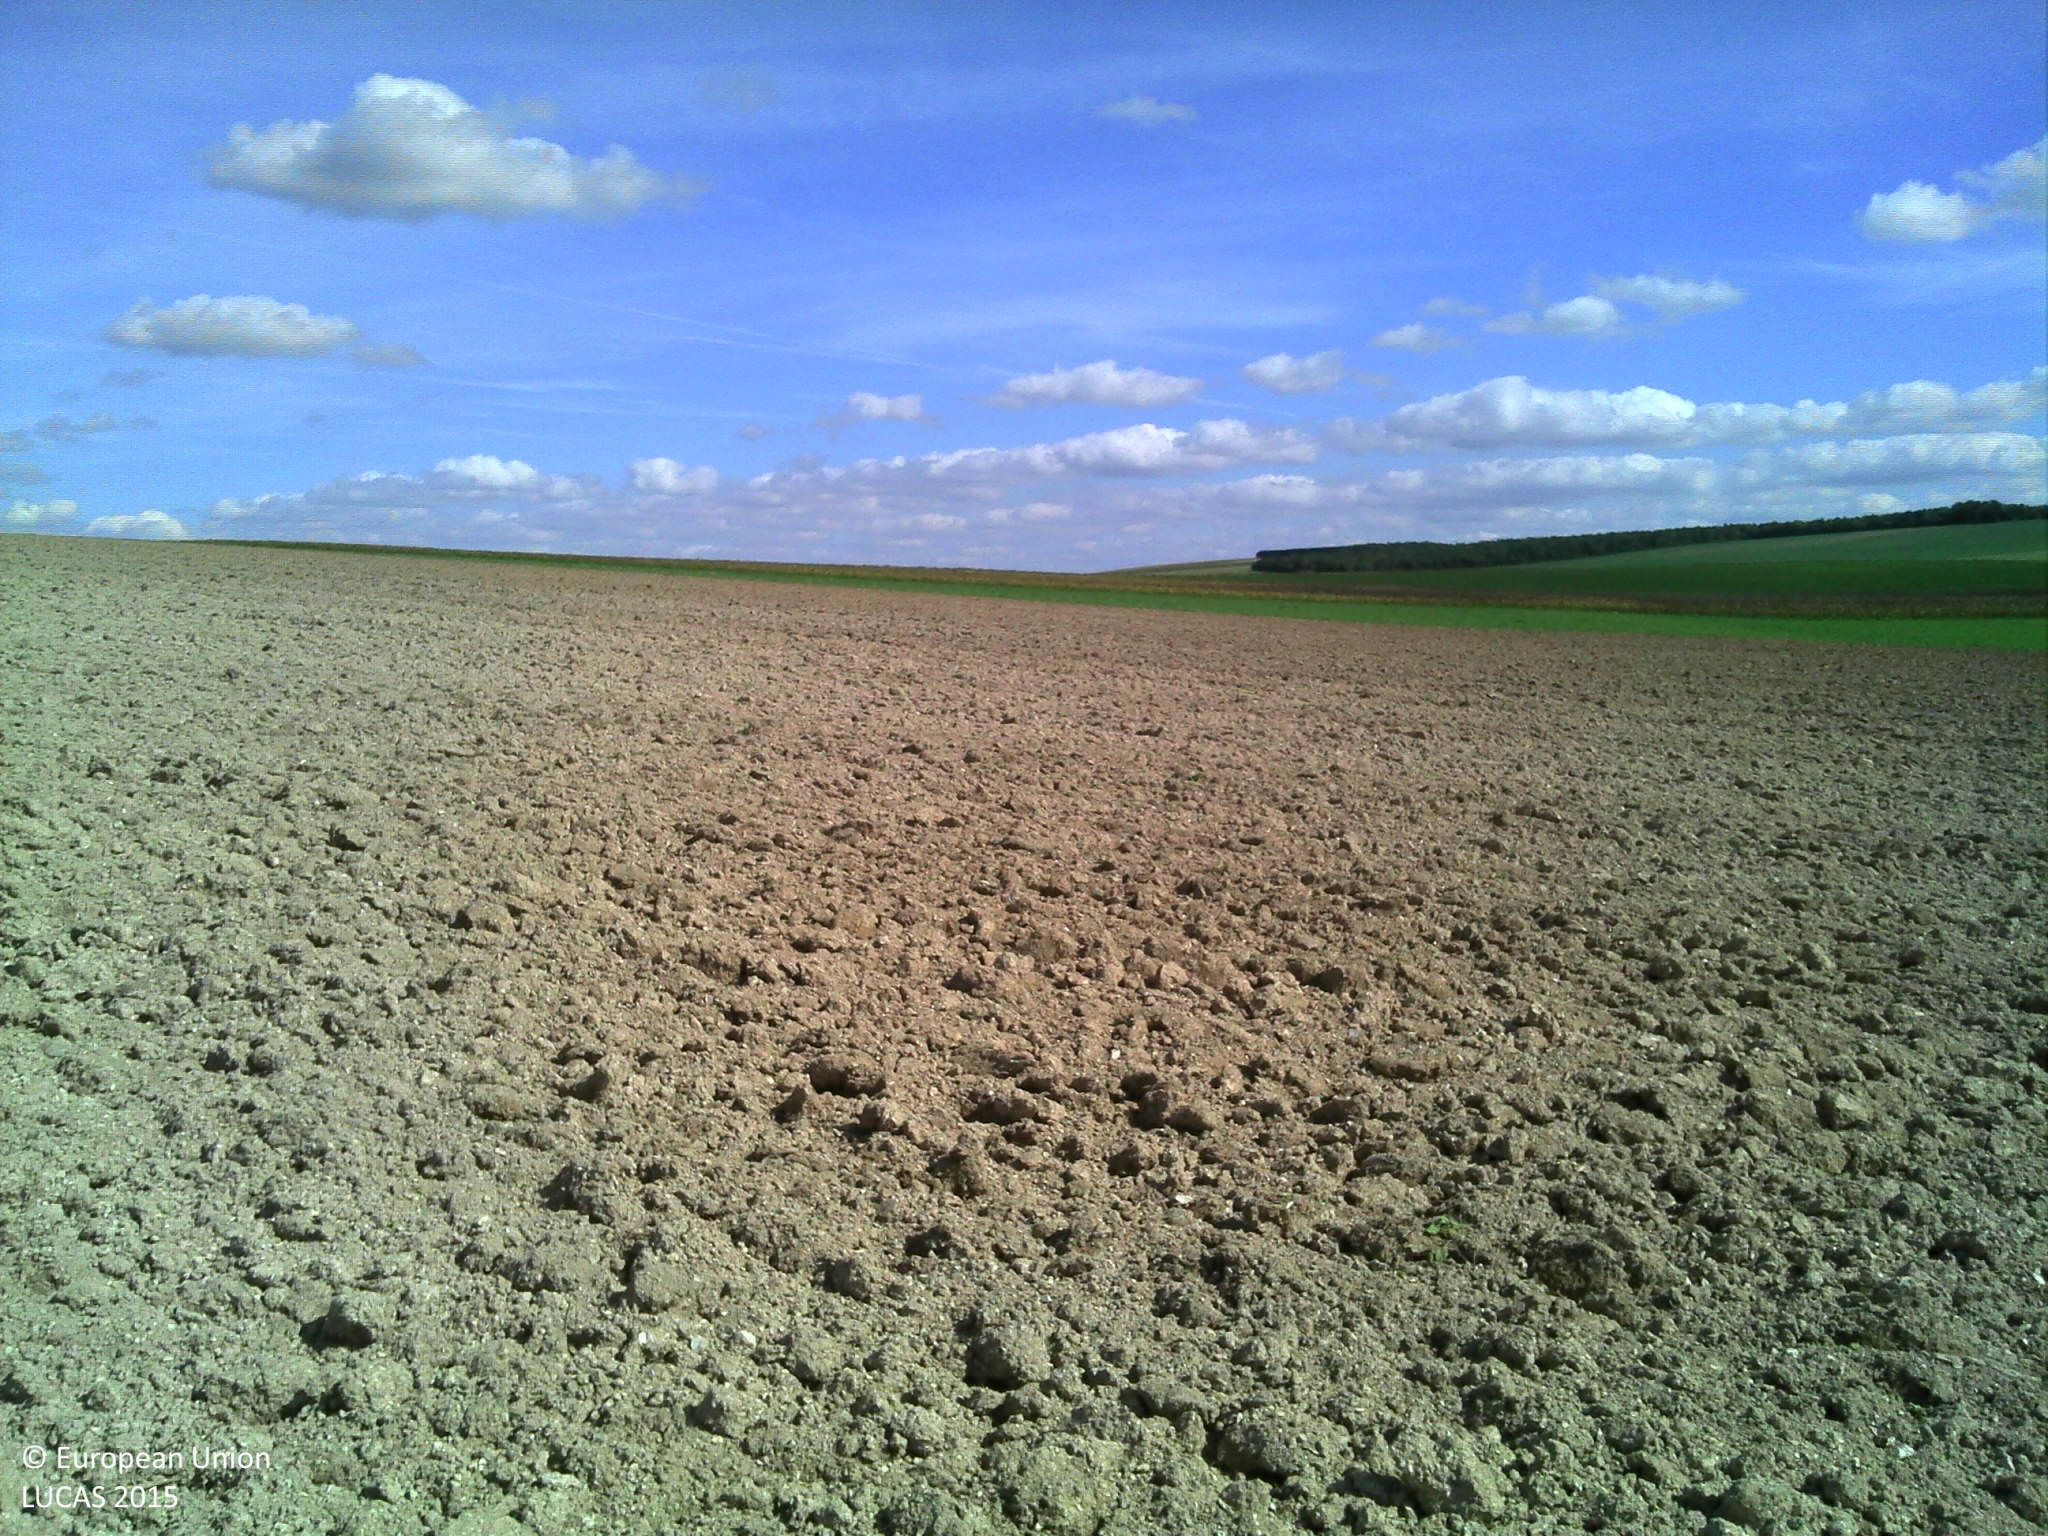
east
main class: Cropland
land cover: Rape and turnip rape
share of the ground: < 10 %
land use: Agriculture (excluding fallow land and kitchen gardens)
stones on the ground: < 10 %
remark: Tilled/Sowed
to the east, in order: Rape and turnip rape; Lucerne; Sunflower
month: September
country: FR
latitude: 48.3036
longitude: 3.8344
